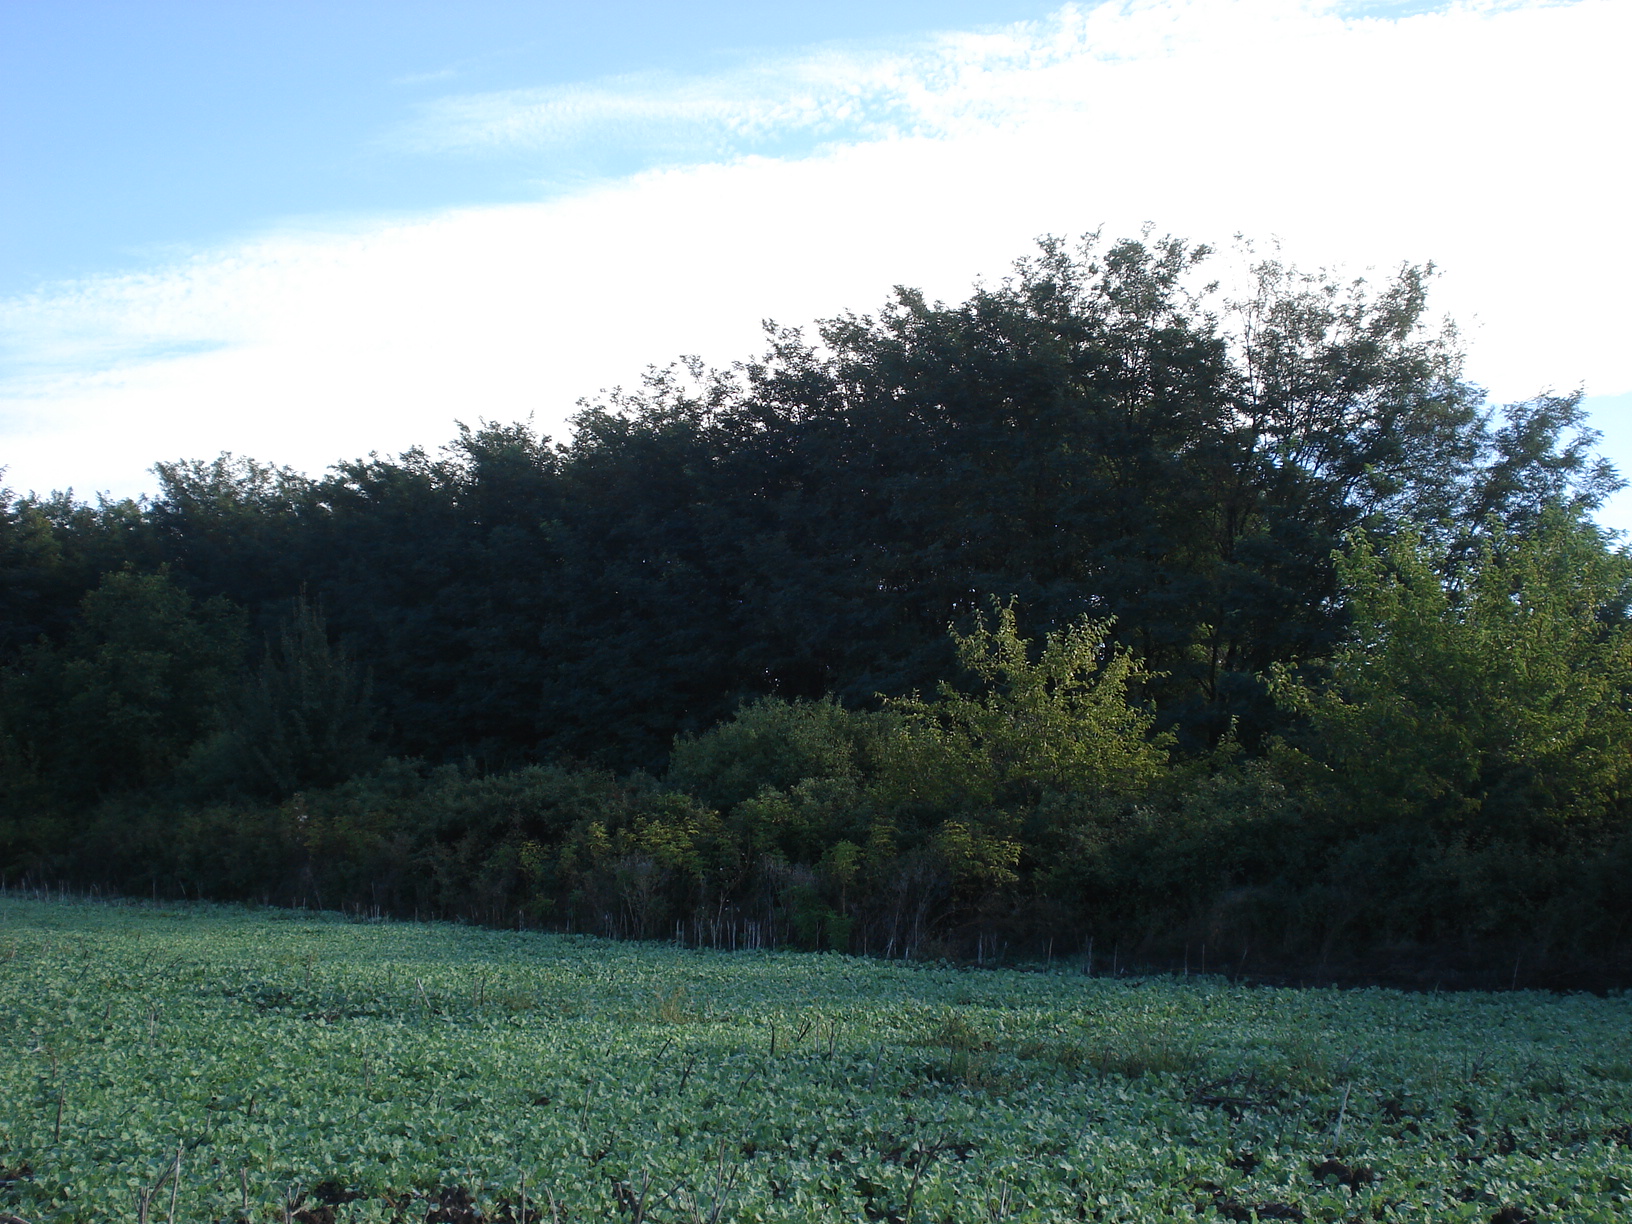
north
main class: Grassland
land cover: Spontaneously vegetated surfaces
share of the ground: > 75 %
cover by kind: herbaceous plants 80 %, unconsolidated bare surface 20 %
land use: Agriculture (excluding fallow land and kitchen gardens)
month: September
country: BG
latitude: 43.2505
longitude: 25.2605
